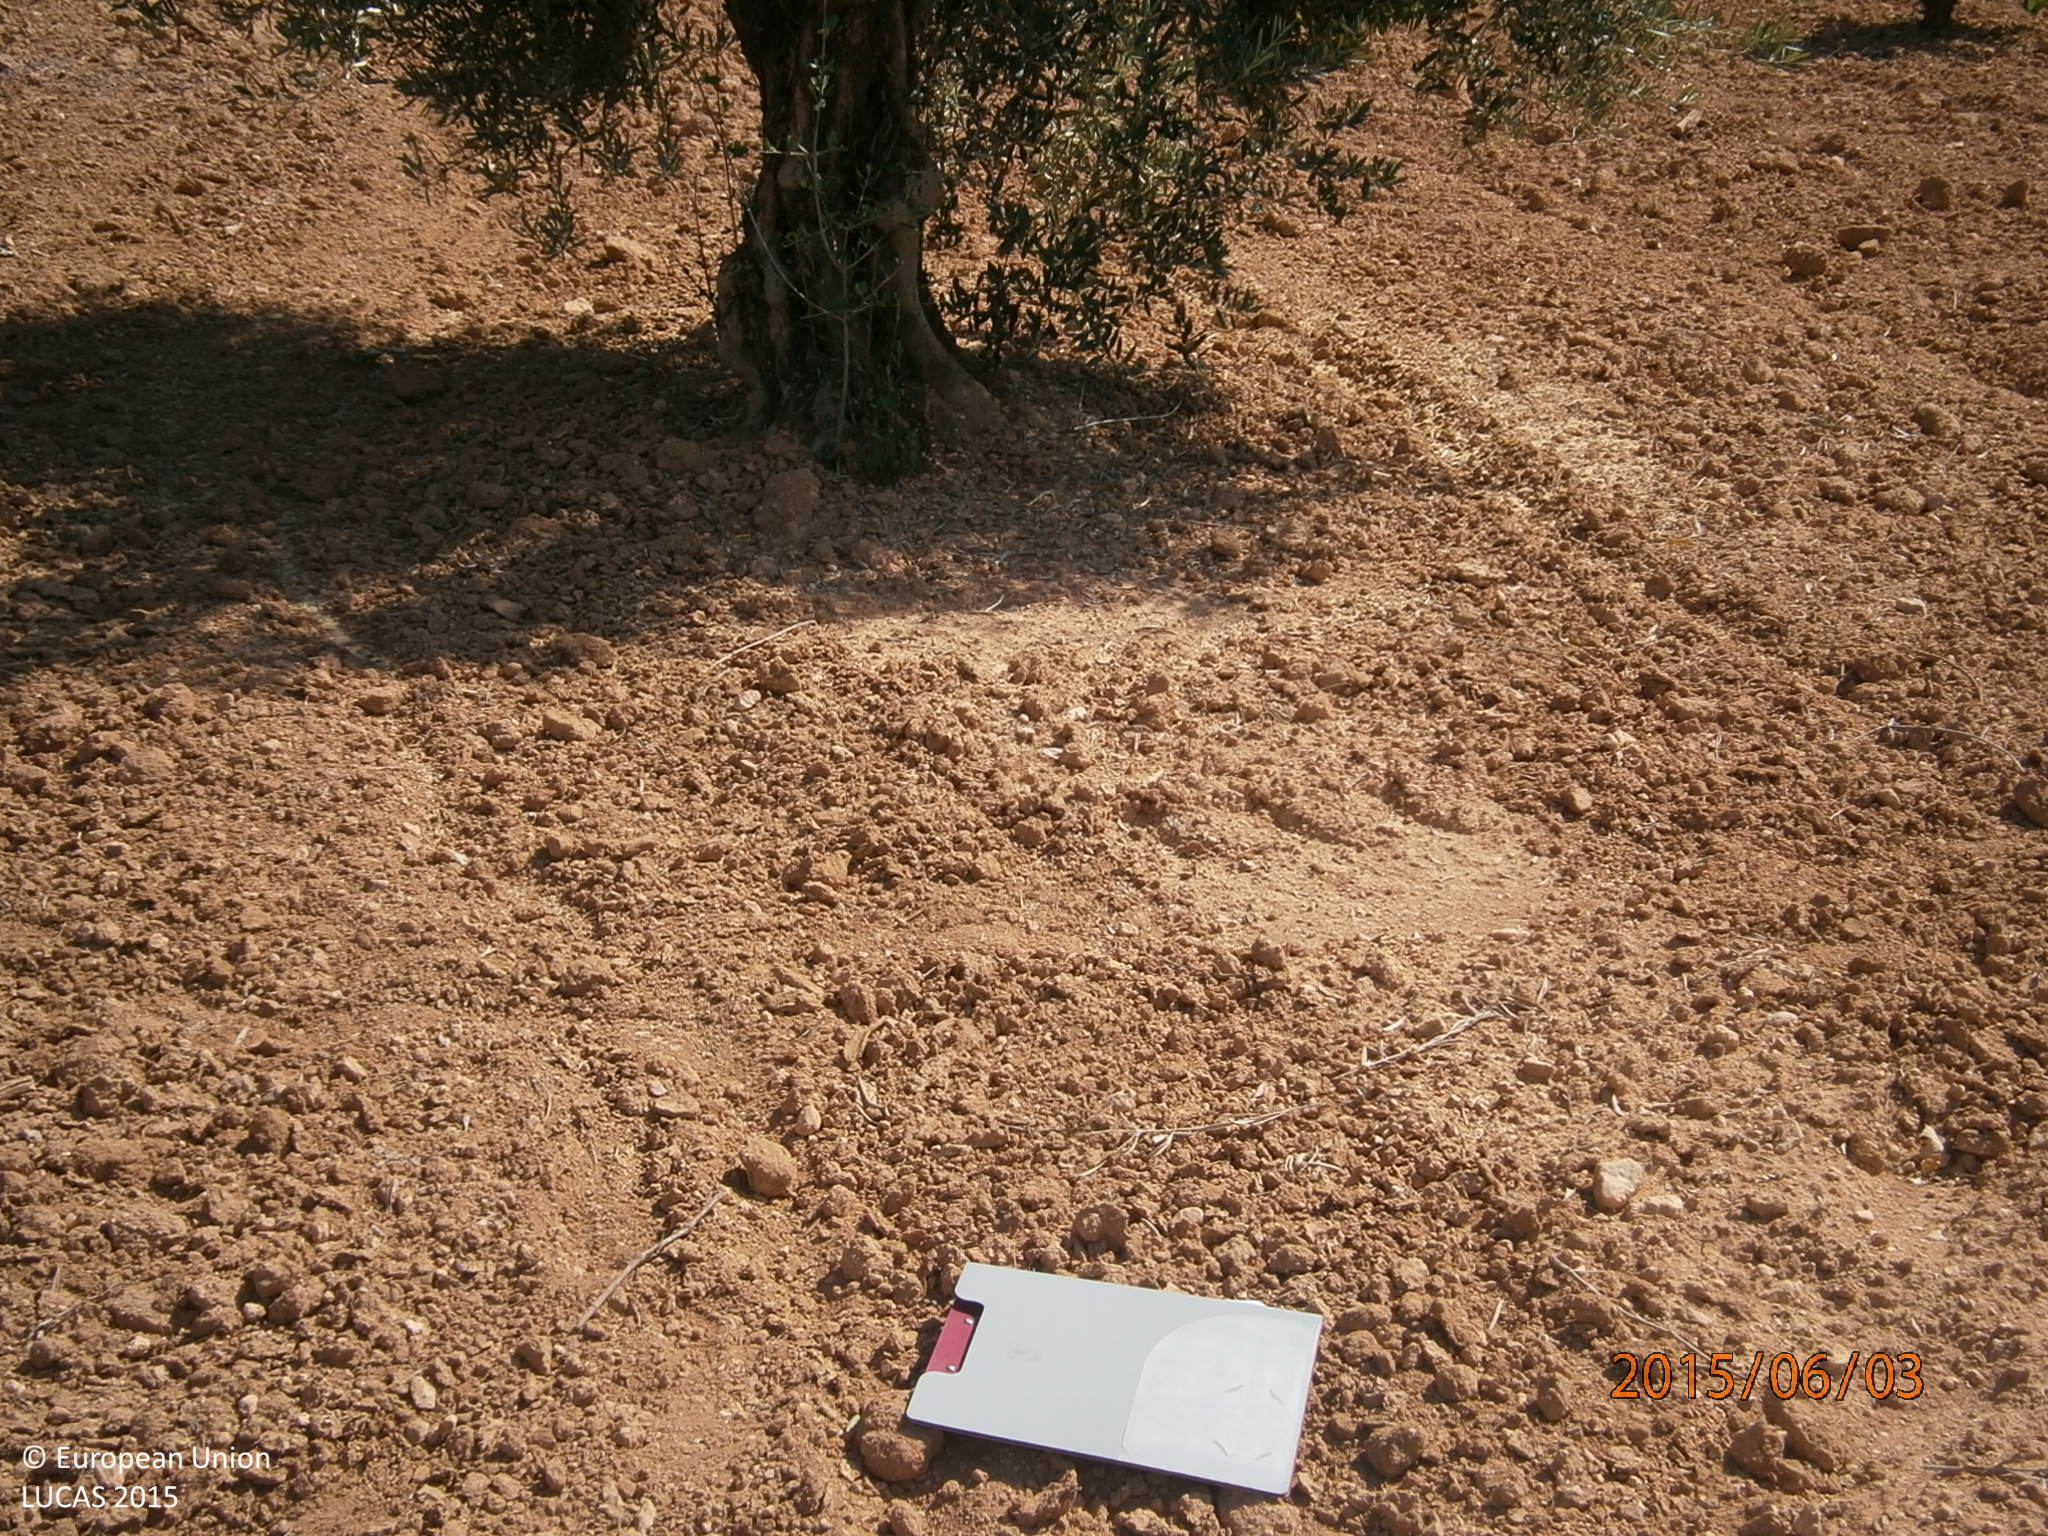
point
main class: Cropland
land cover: Olive groves
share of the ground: 10 - 25 %
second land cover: Vineyards
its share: 25 - 50 %
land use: Agriculture (excluding fallow land and kitchen gardens)
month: June
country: ES
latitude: 38.6545
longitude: -6.4060
